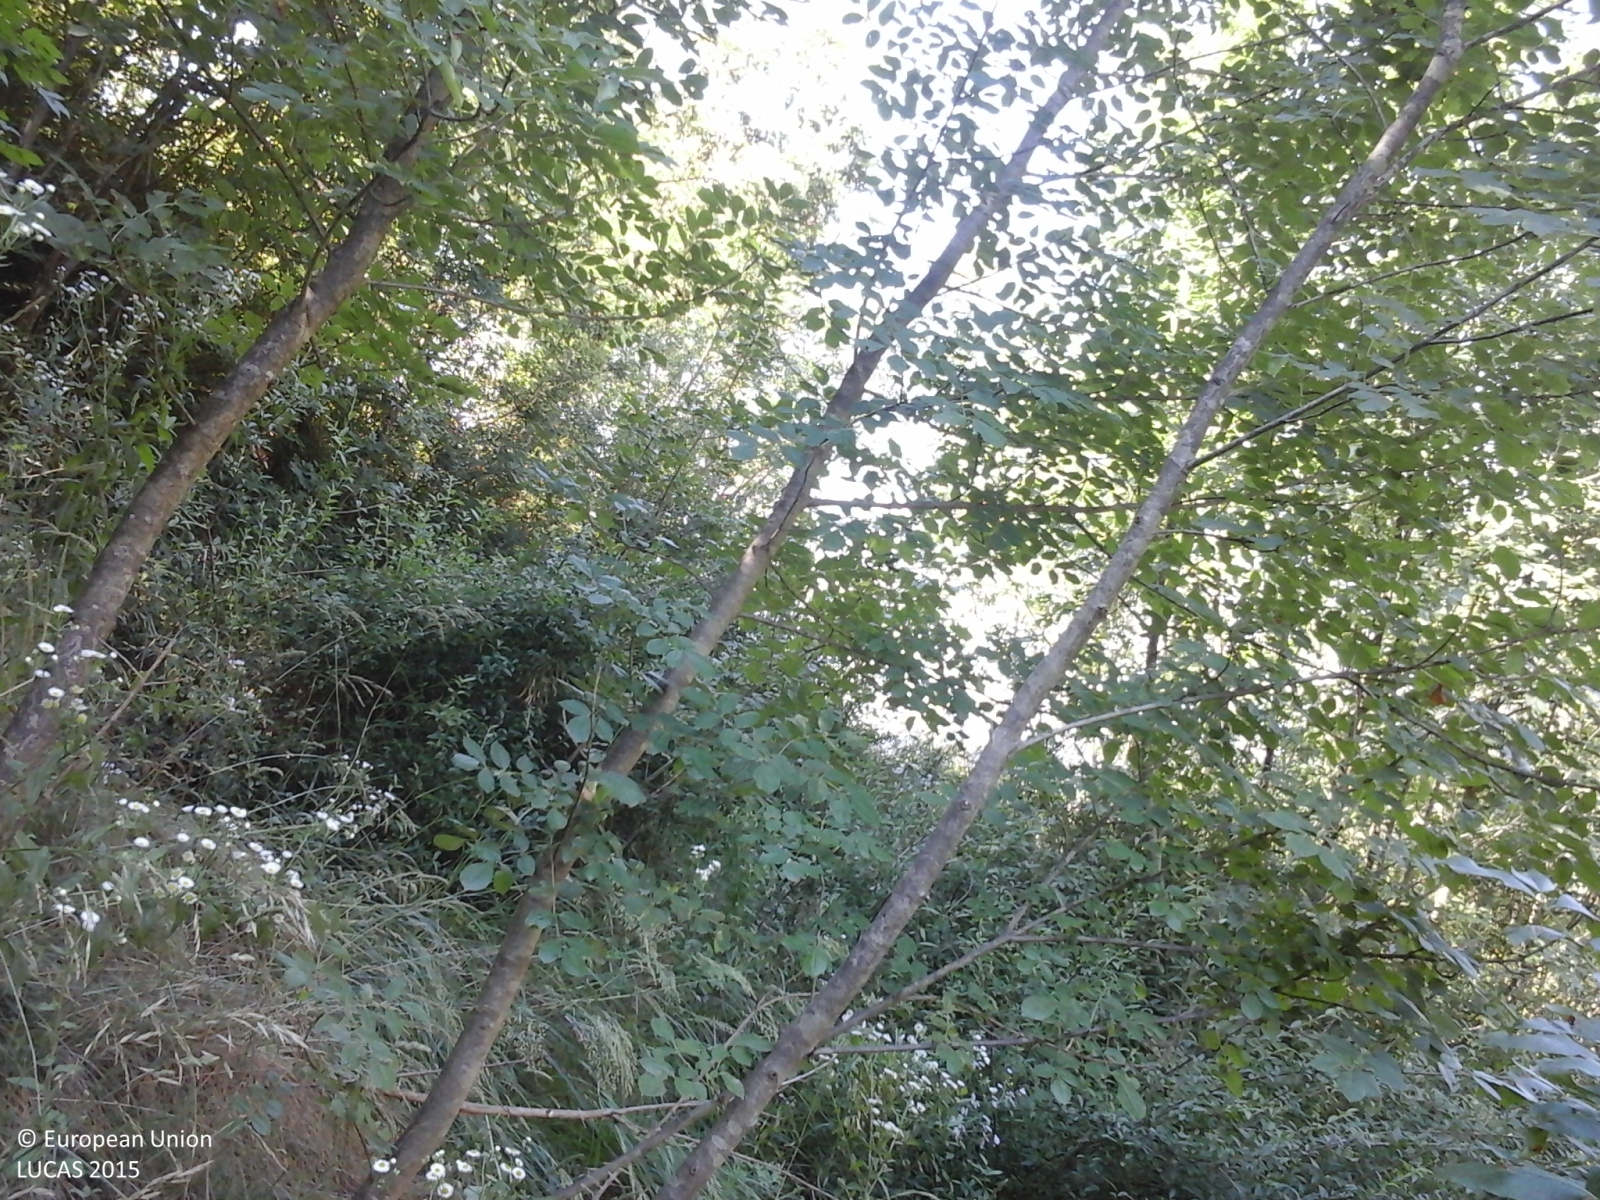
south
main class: Woodland
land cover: Broadleaved woodland
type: thermophilous deciduous forest
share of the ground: > 75 %
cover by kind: broadleaved forest trees 85 %, herbaceous plants 10 %, shrubs 5 %
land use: Semi-natural and natural areas not in use
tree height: < 5 m
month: June
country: IT
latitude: 44.5175
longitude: 8.3303
